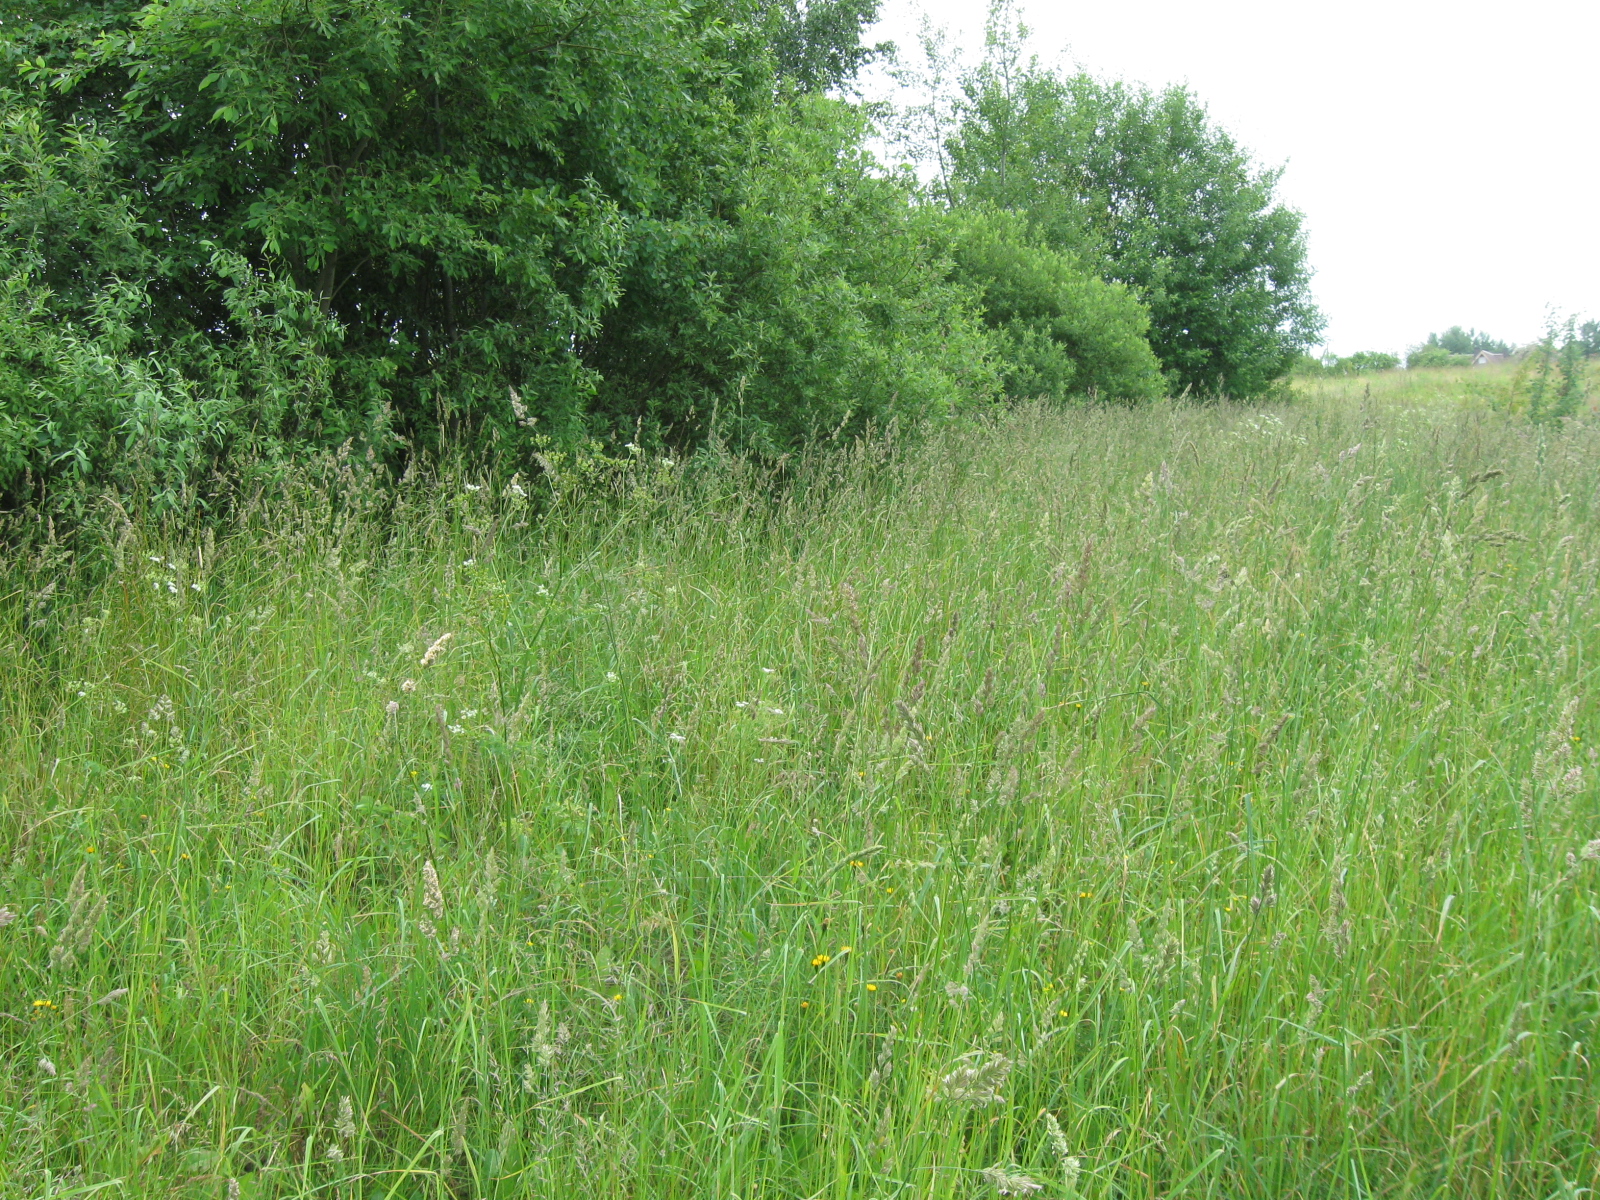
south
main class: Grassland
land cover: Grassland without tree/shrub cover
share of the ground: > 75 %
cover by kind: herbaceous plants 100 %
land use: Agriculture (excluding fallow land and kitchen gardens)
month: June
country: LT
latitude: 54.9288
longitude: 24.5697
